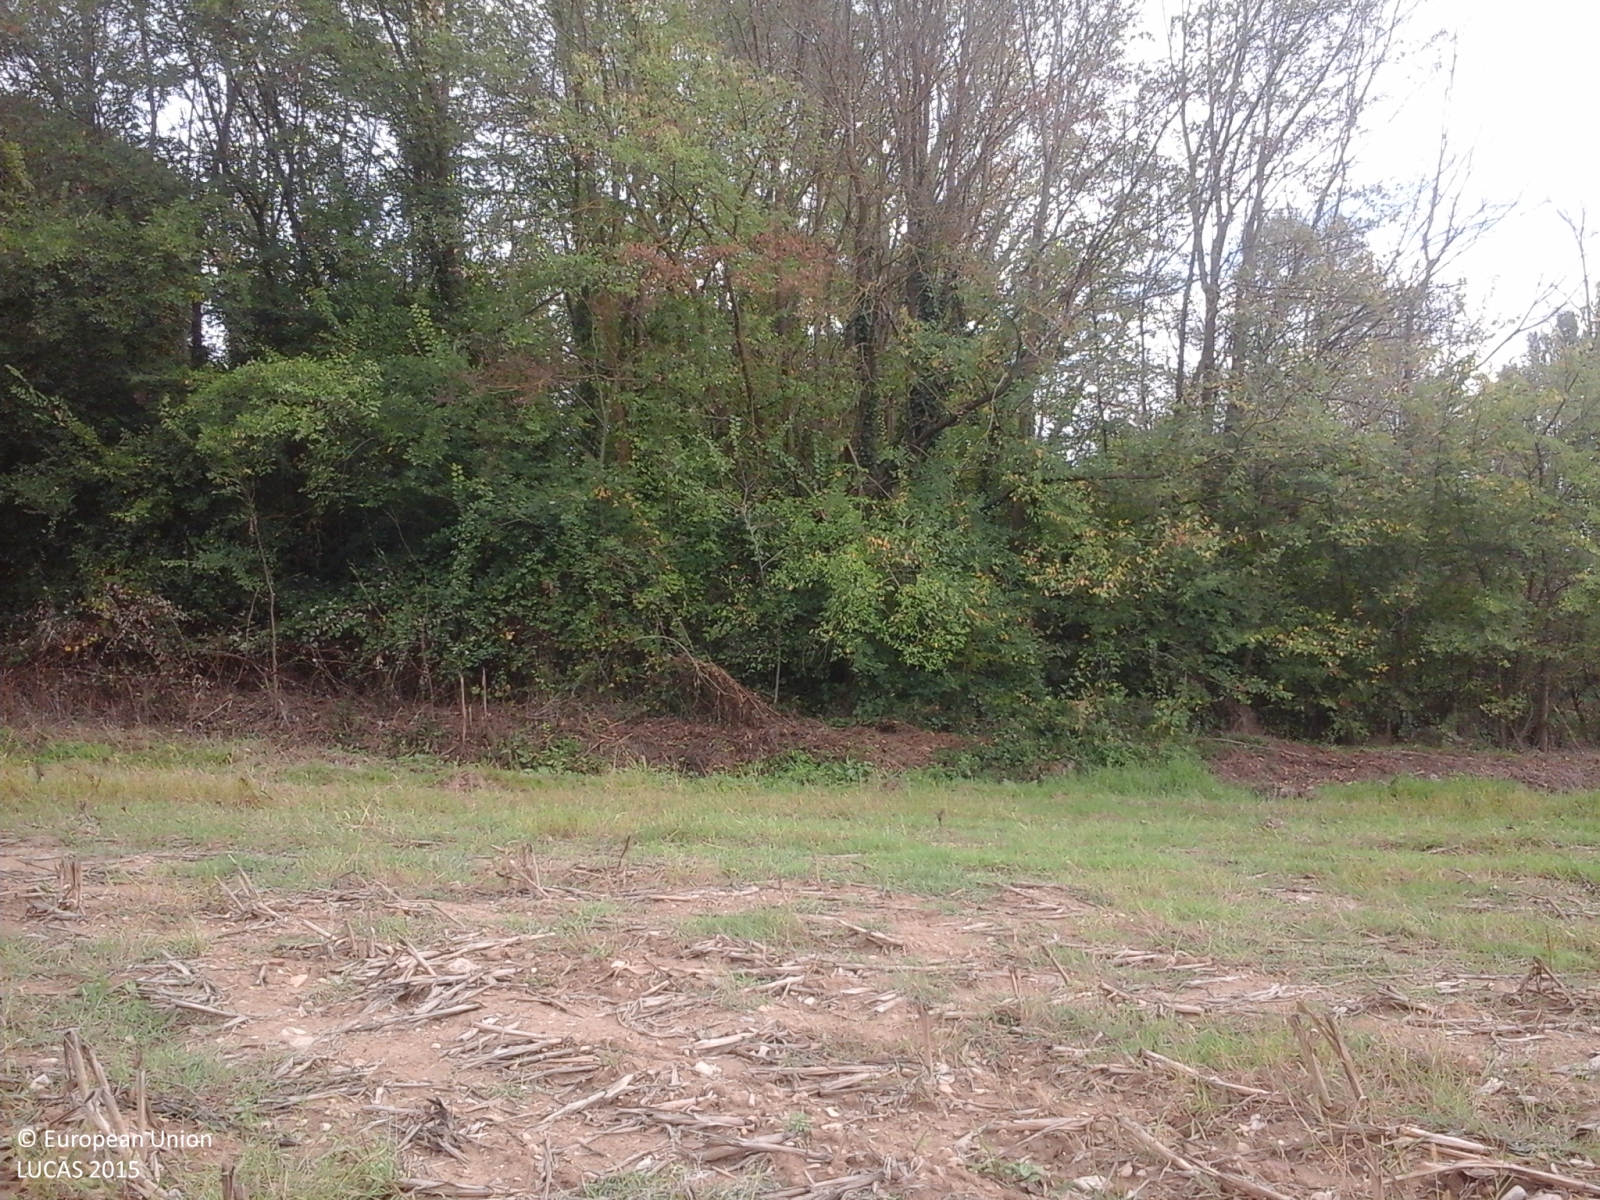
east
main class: Cropland
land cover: Maize
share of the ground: < 10 %
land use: Agriculture (excluding fallow land and kitchen gardens)
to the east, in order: Maize; Broadleaved woodland; Artificial constructions in urban areas; Shruby margins; Grassland without tree/shrub cover; Tracks; Grassland without tree/shrub cover; Artificial constructions in urban areas; Broadleaved woodland; Shruby margins; Electric lines; Spontaneously vegetated surfaces
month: October
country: IT
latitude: 43.3695
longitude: 12.2522
